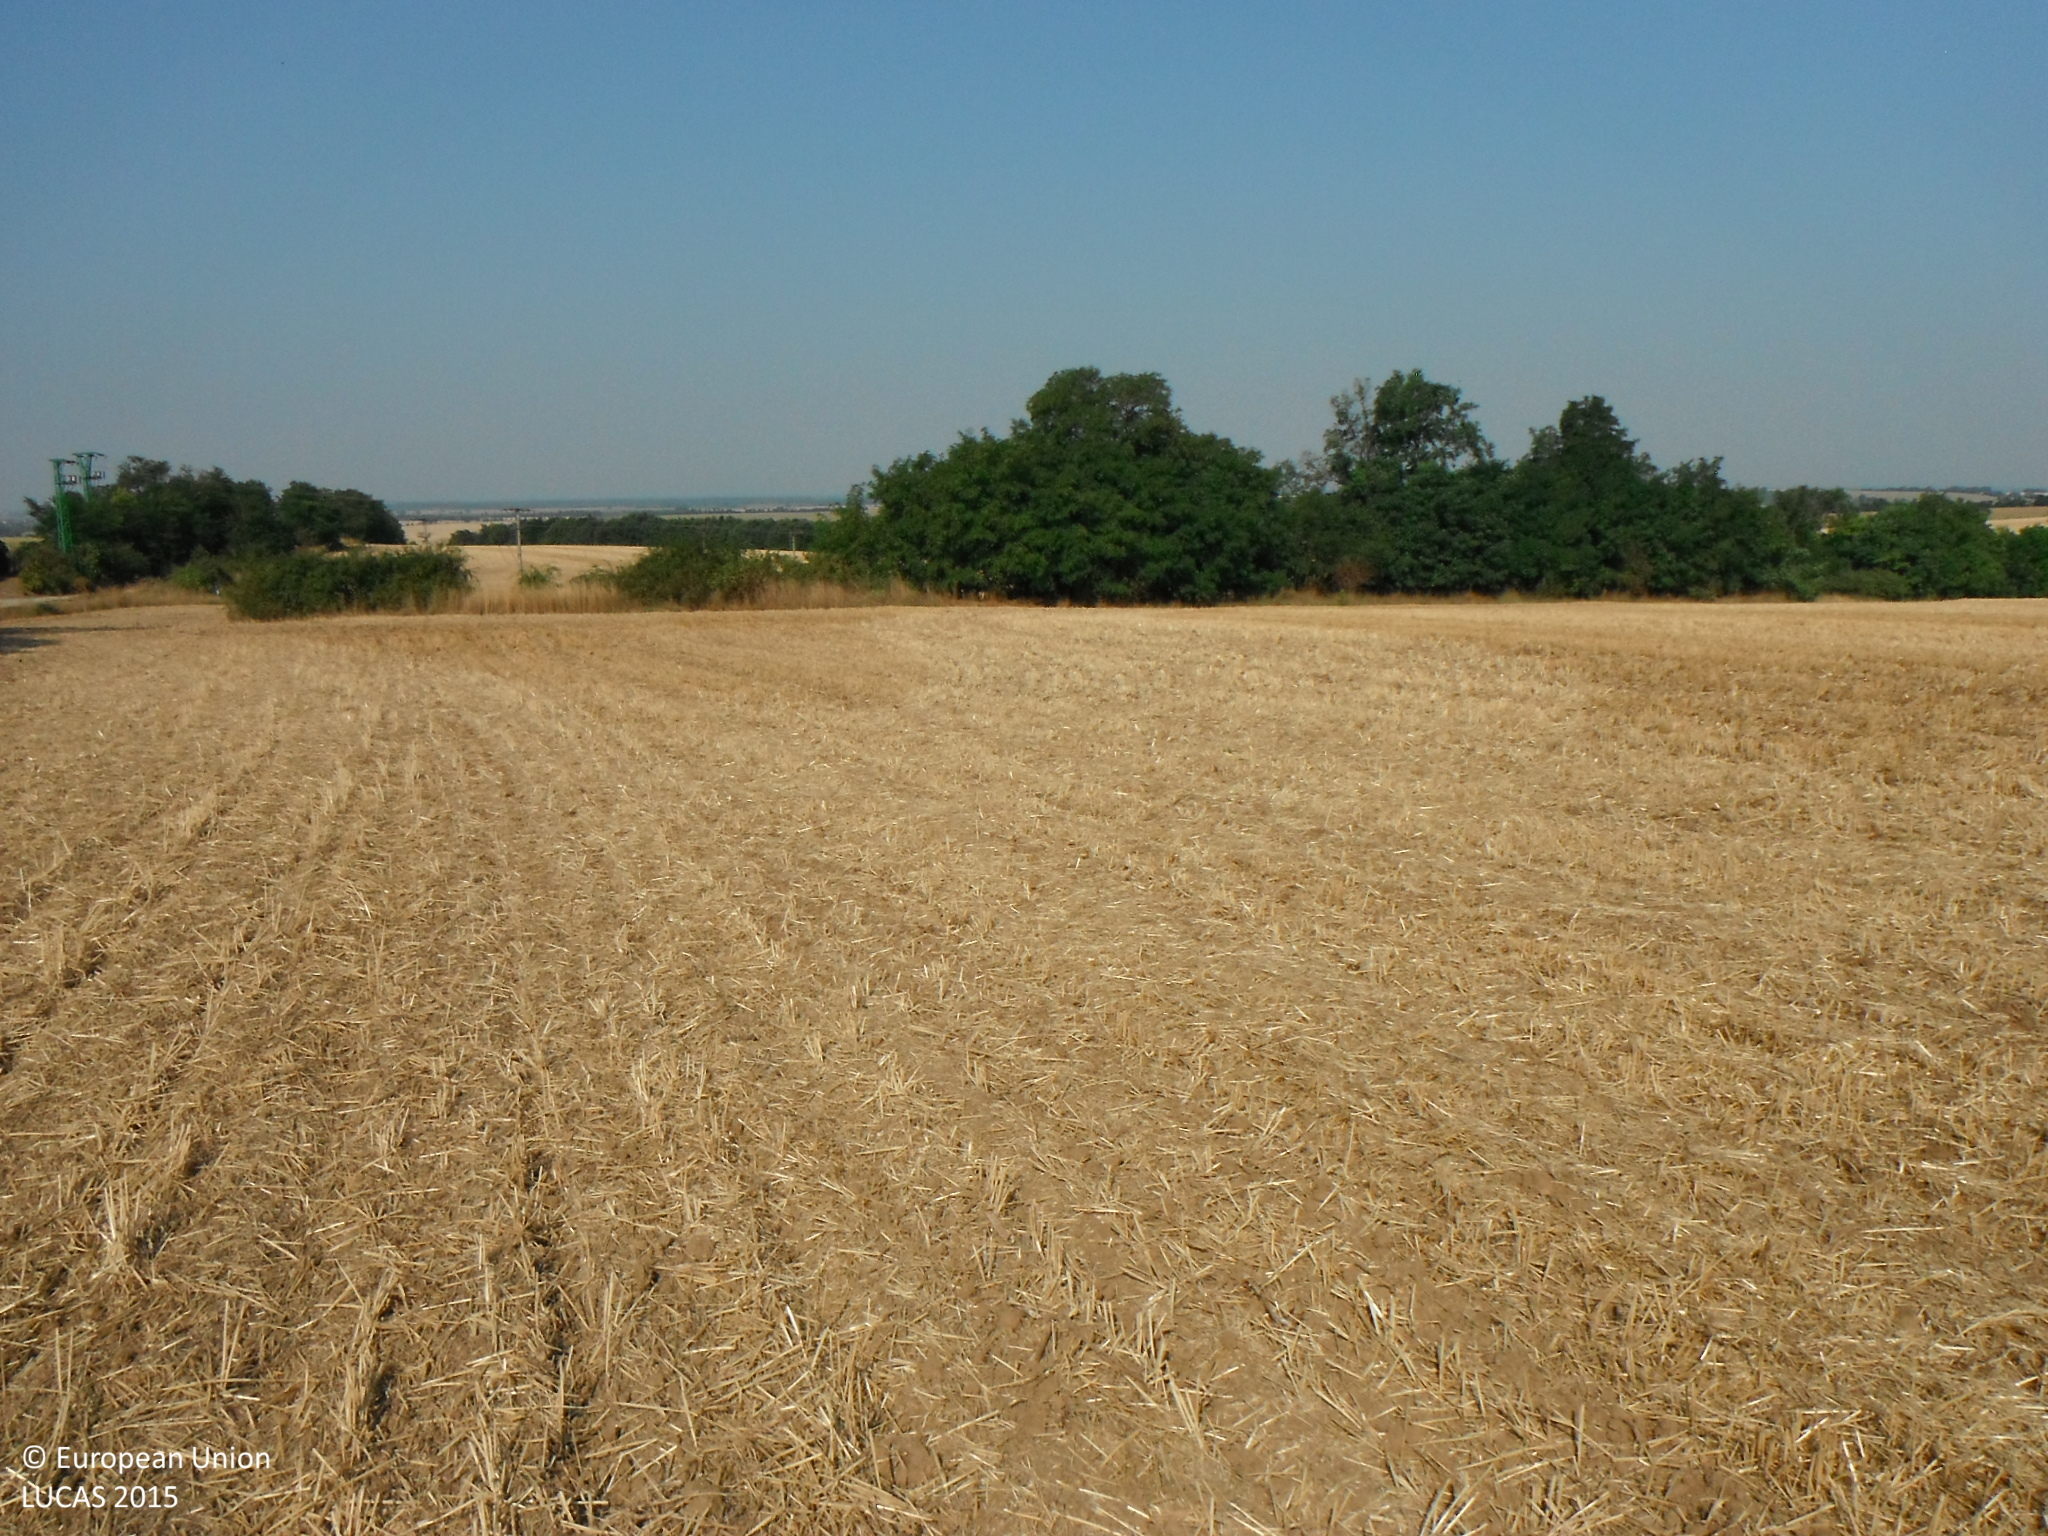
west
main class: Cropland
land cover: Common wheat
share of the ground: > 75 %
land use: Agriculture (excluding fallow land and kitchen gardens)
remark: Harvested field
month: August
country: SK
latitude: 48.0335
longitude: 18.3429
